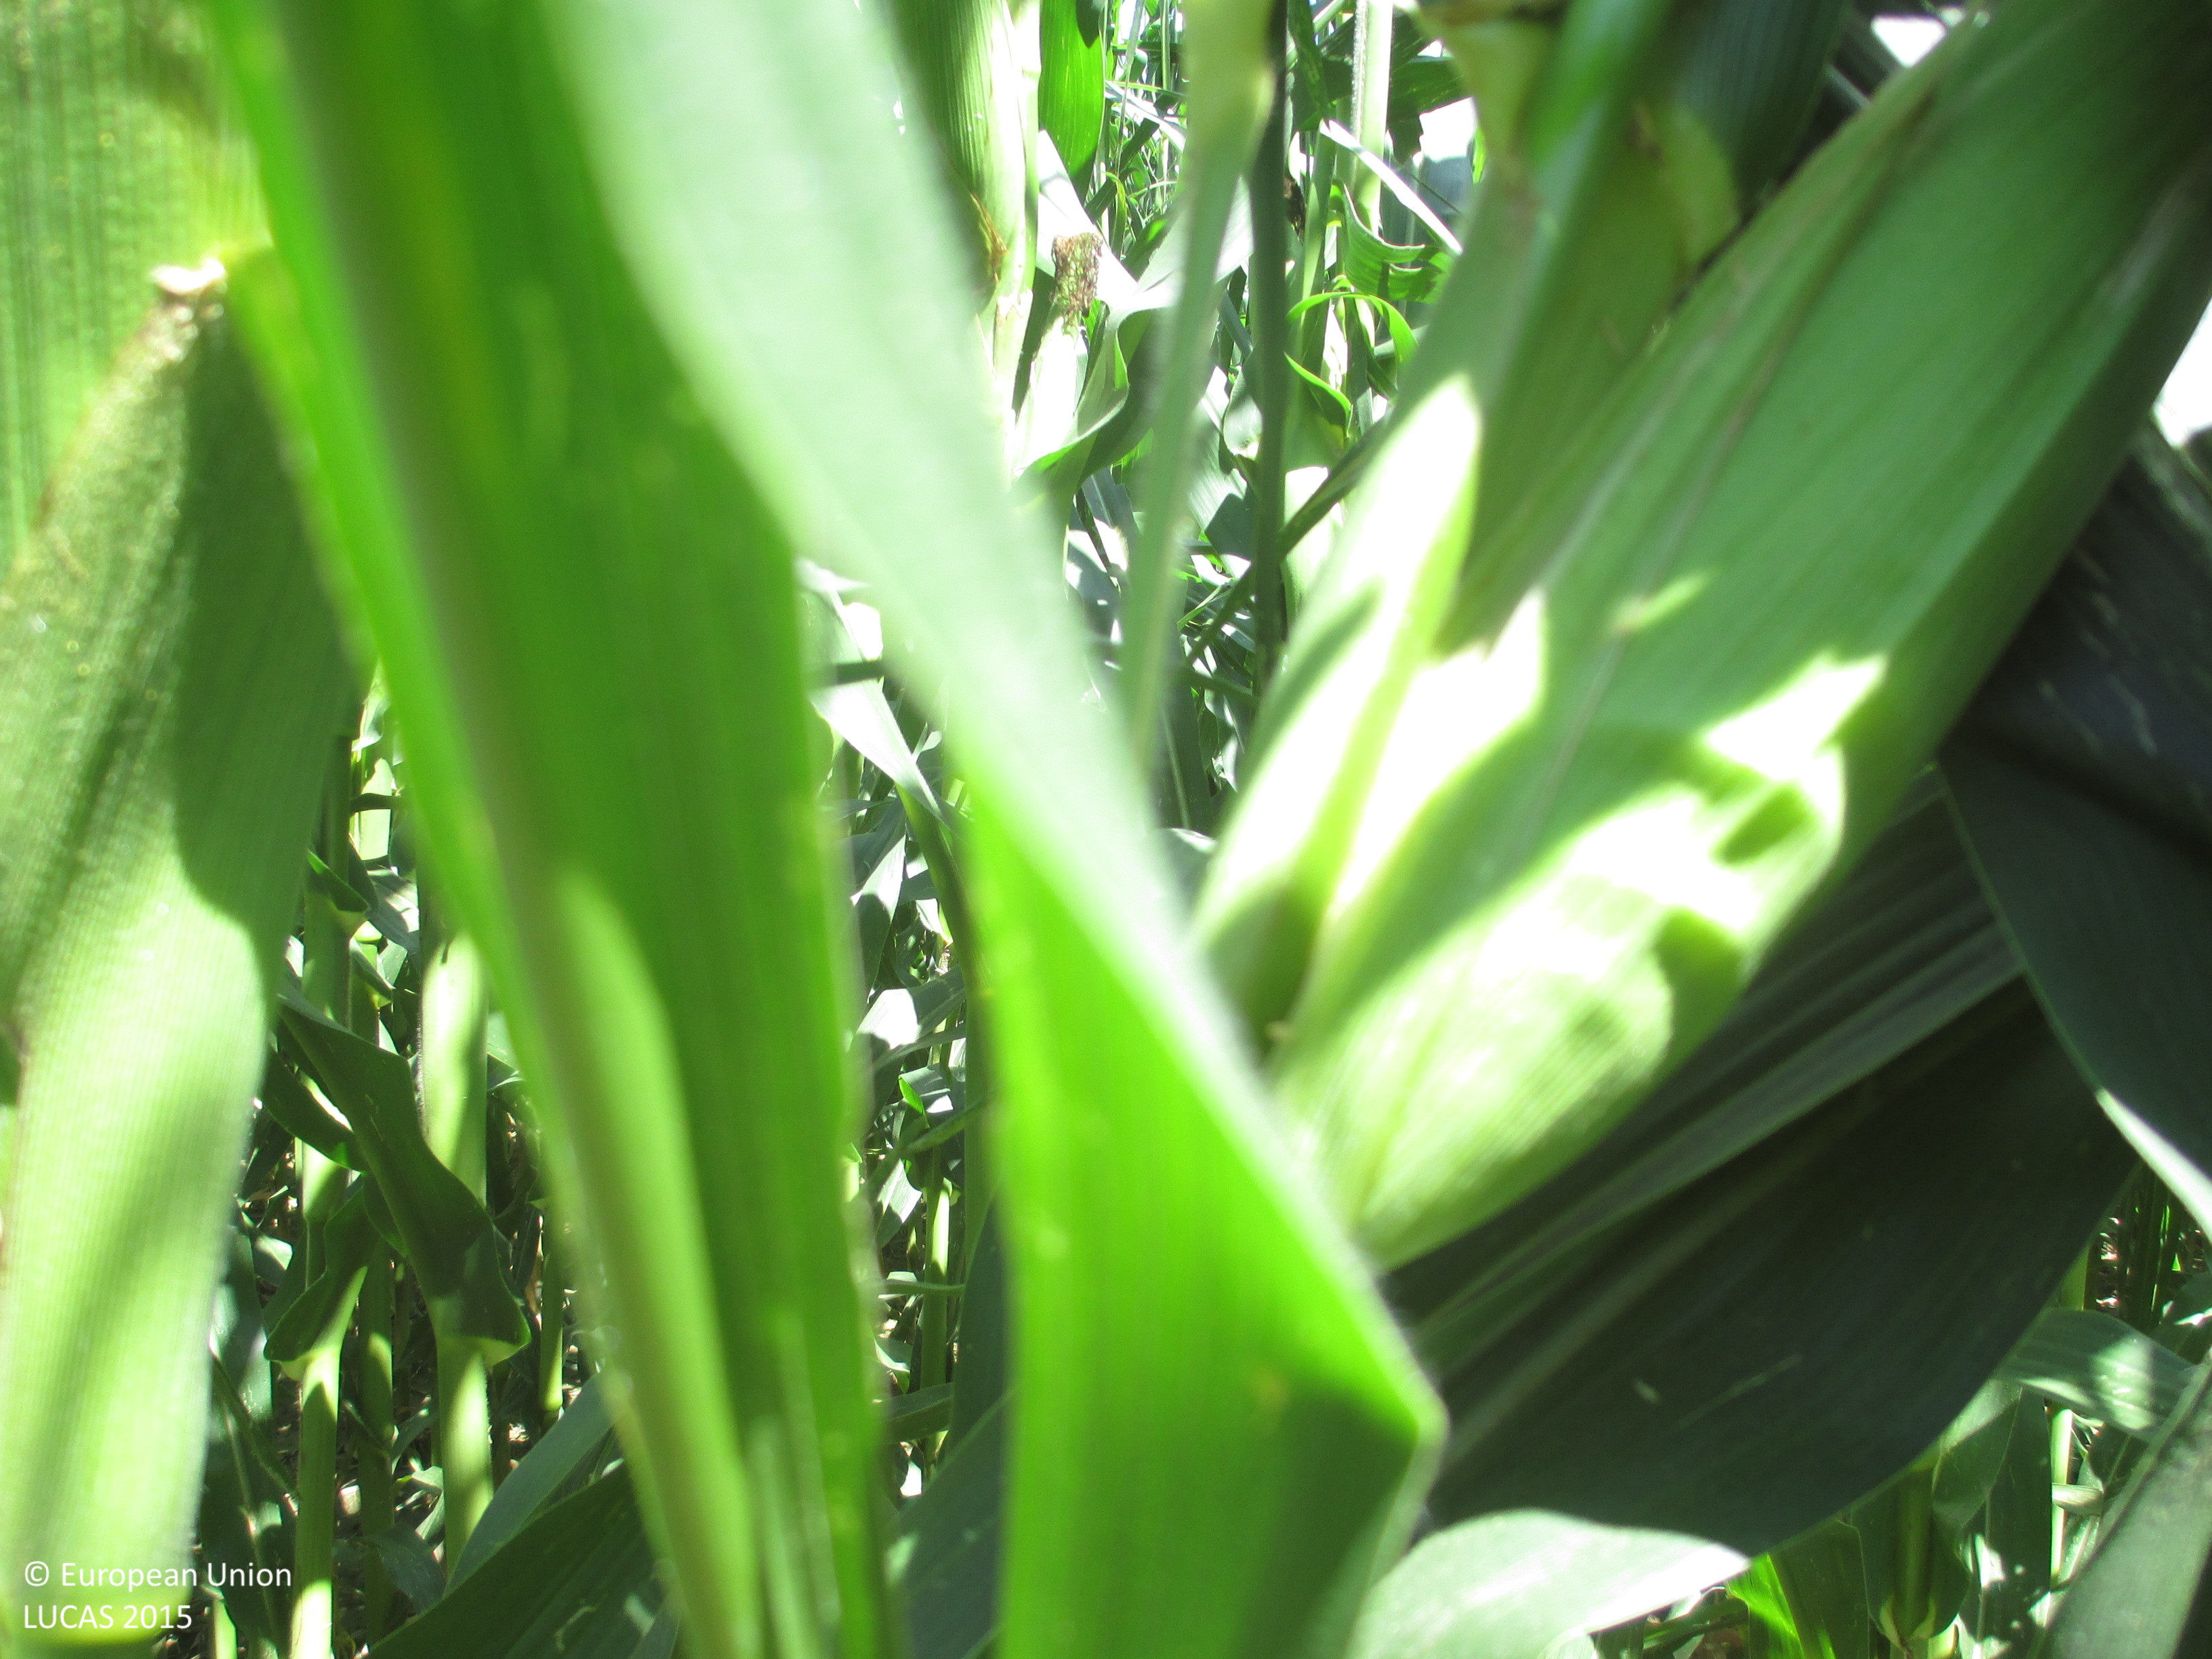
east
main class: Cropland
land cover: Maize
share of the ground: > 75 %
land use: Agriculture (excluding fallow land and kitchen gardens)
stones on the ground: < 10 %
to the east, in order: Maize
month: July
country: ES
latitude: 41.9320
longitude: 0.1053
